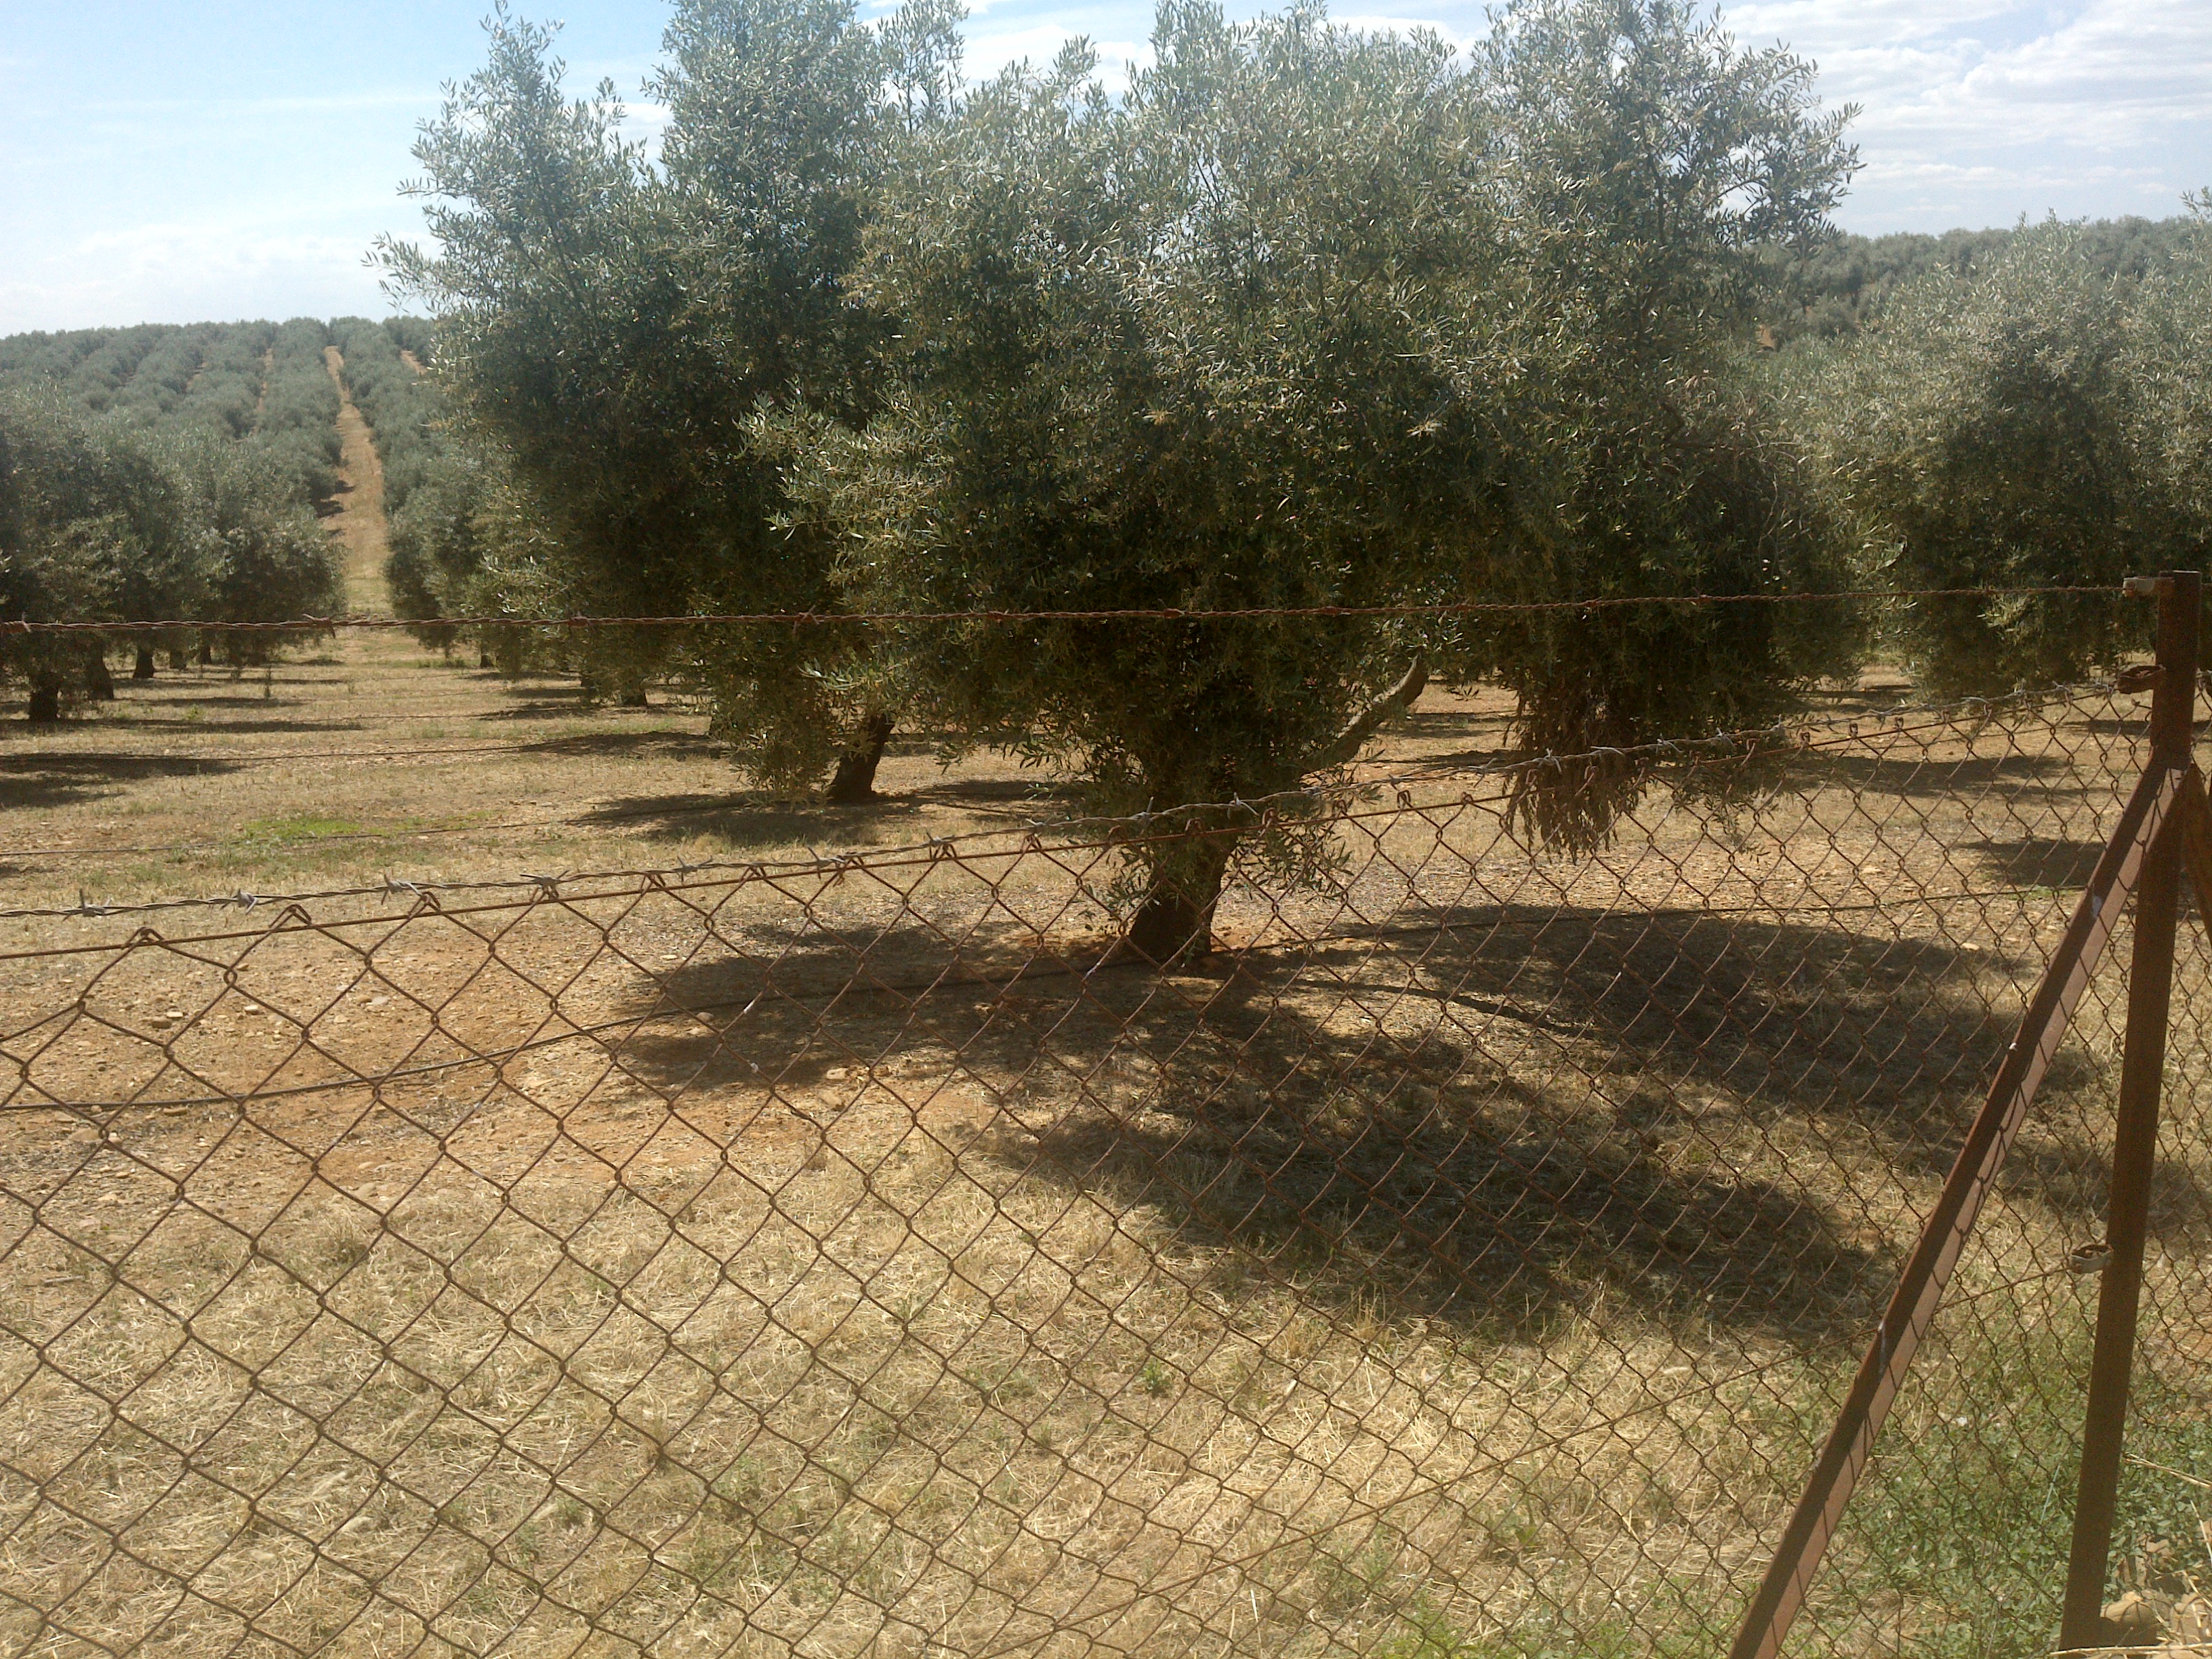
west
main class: Cropland
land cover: Olive groves
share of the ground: 50 - 75 %
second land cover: Spontaneously vegetated surfaces
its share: 25 - 50 %
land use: Agriculture (excluding fallow land and kitchen gardens)
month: May
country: ES
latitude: 37.9610
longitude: -4.5704
